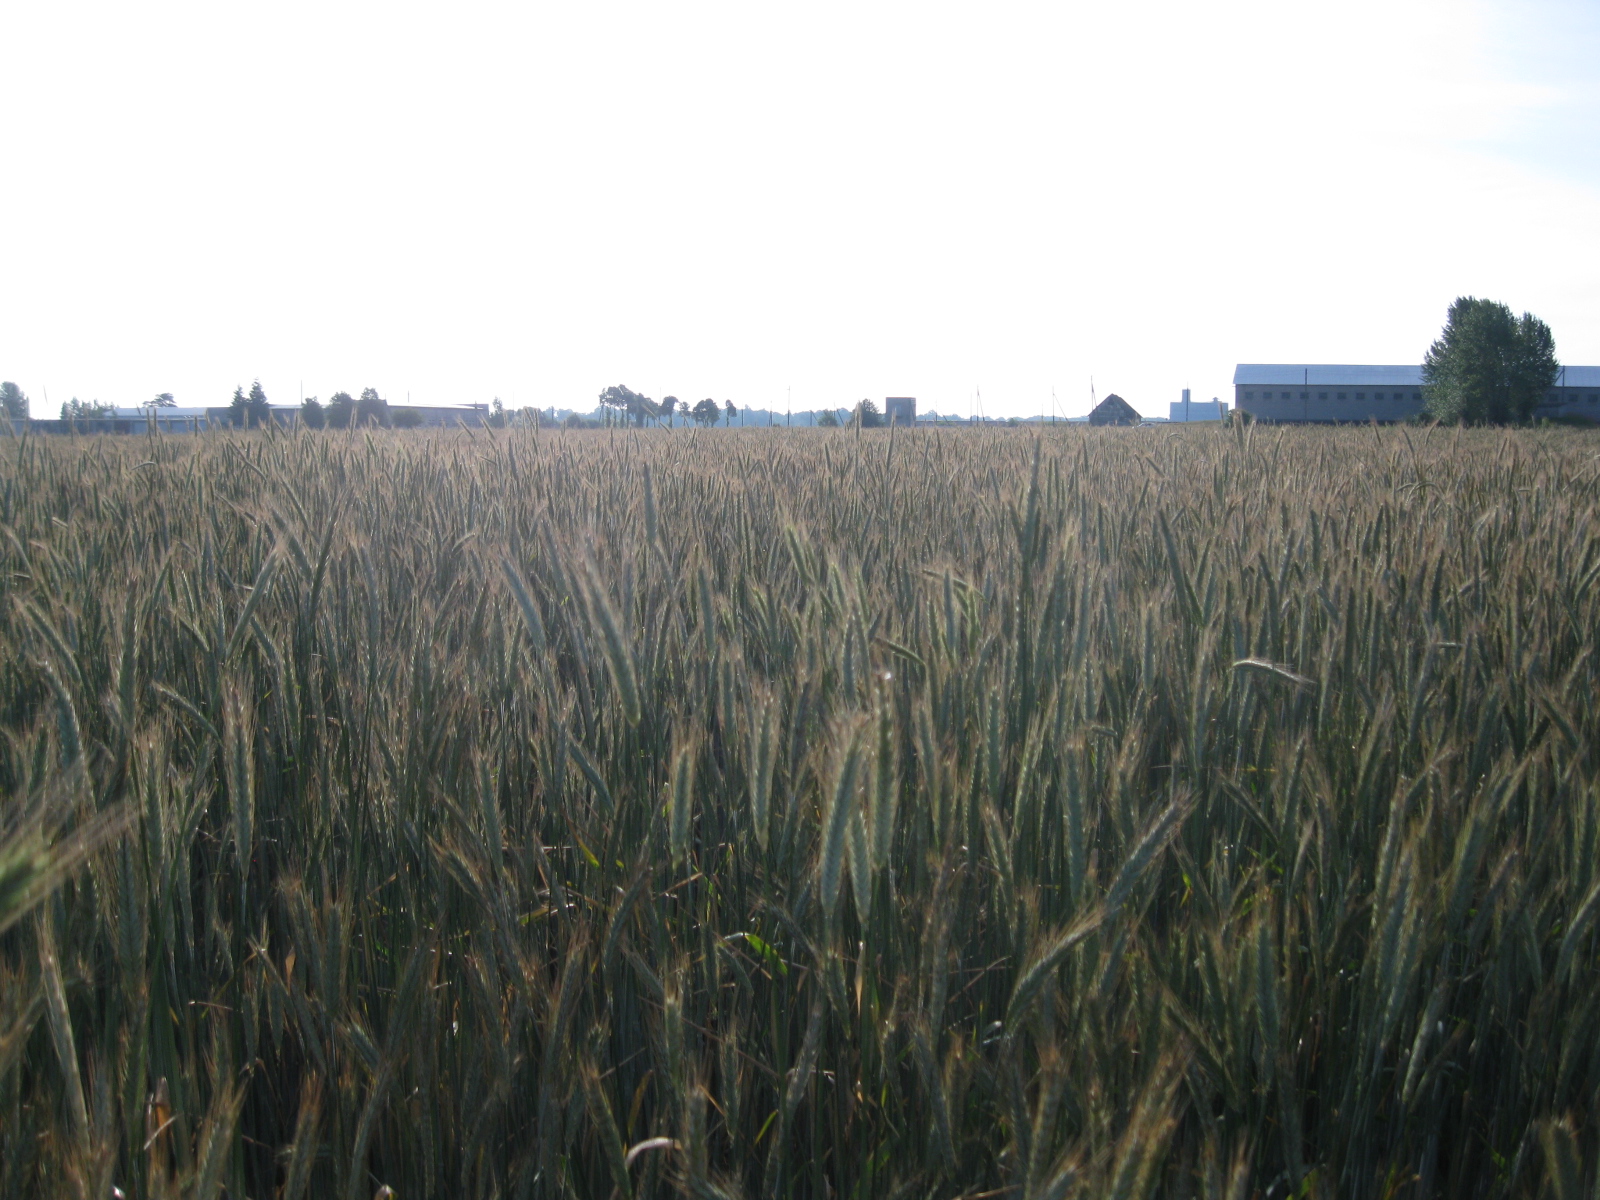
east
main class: Cropland
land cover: Rye
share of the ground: > 75 %
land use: Agriculture (excluding fallow land and kitchen gardens)
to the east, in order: Rye; Common wheat; Grassland without tree/shrub cover
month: June
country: LT
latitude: 55.2387
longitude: 24.1046
